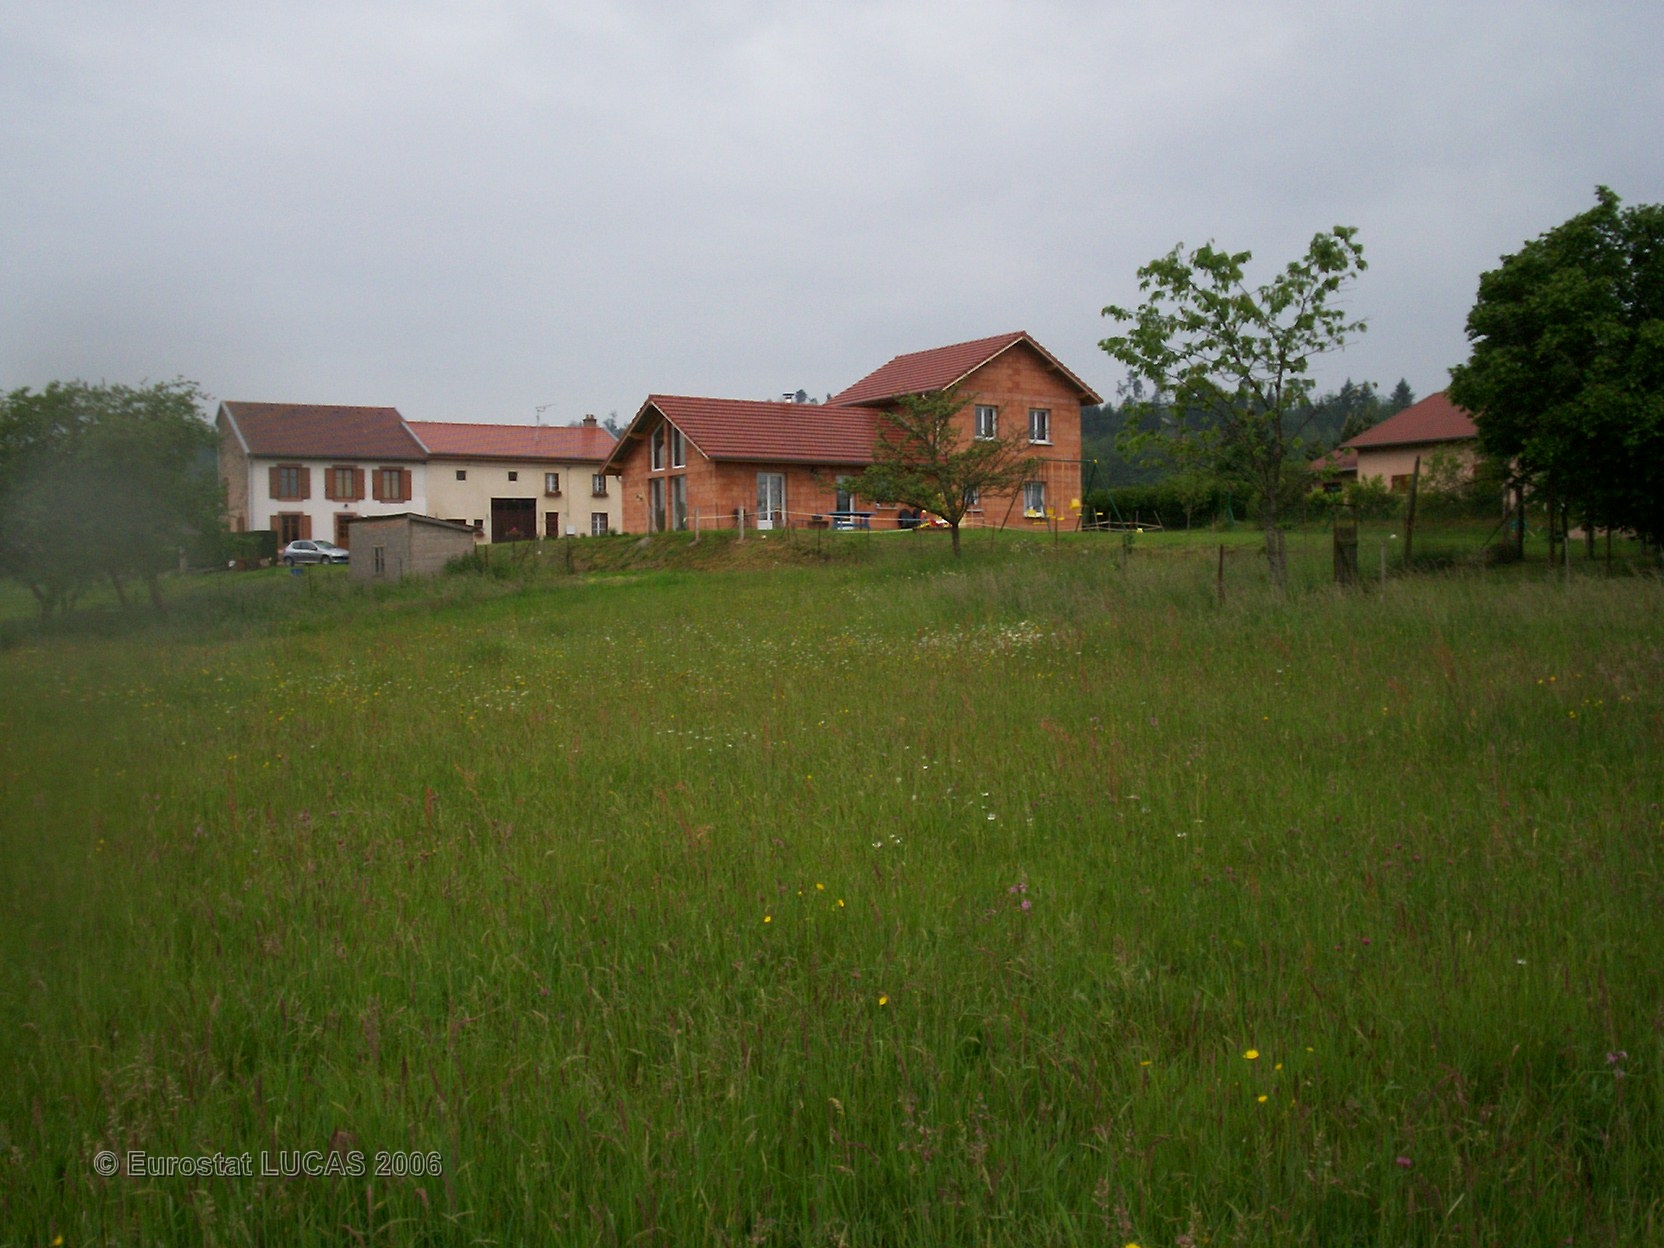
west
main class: Grassland
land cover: Grassland without tree/shrub cover
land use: Agriculture (excluding fallow land and kitchen gardens)
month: June
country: FR
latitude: 48.4112
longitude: 6.7988
